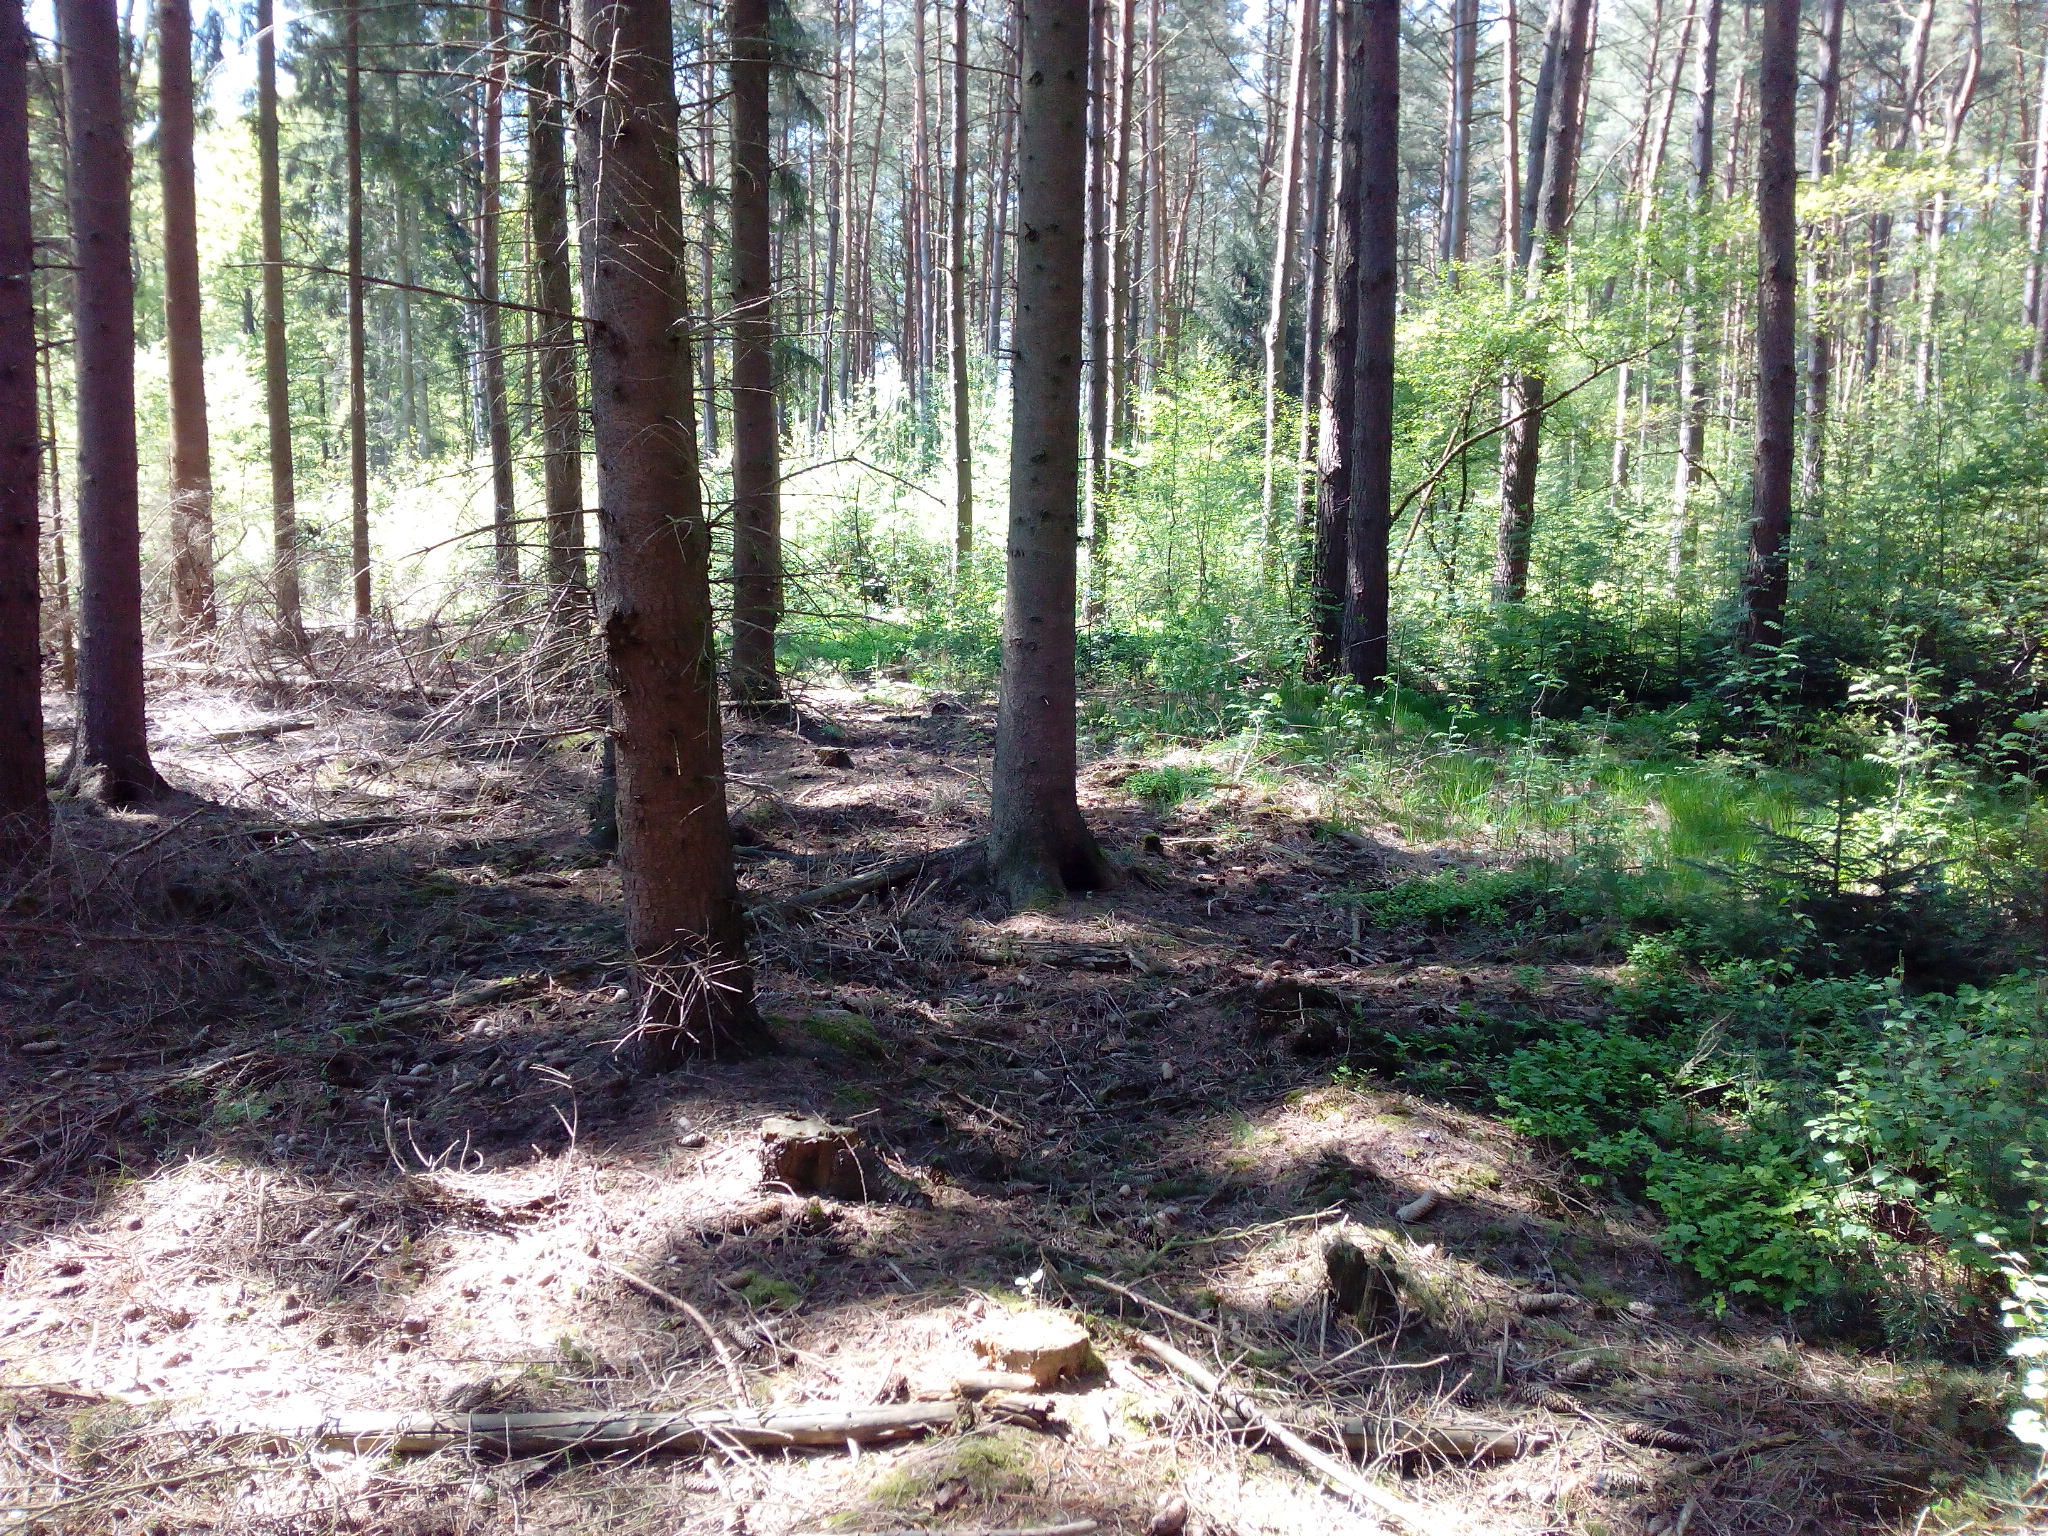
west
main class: Woodland
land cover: Spruce dominated mixed woodland
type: hemiboreal forest and nemoral coniferous forest and mixed broadleaved-coniferous forest
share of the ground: > 75 %
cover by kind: coniferous forest trees 60 %, broadleaved forest trees 30 %, herbaceous plants 10 %
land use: Forestry
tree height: > 5 m
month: May
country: DE
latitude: 52.5207
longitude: 9.6317
